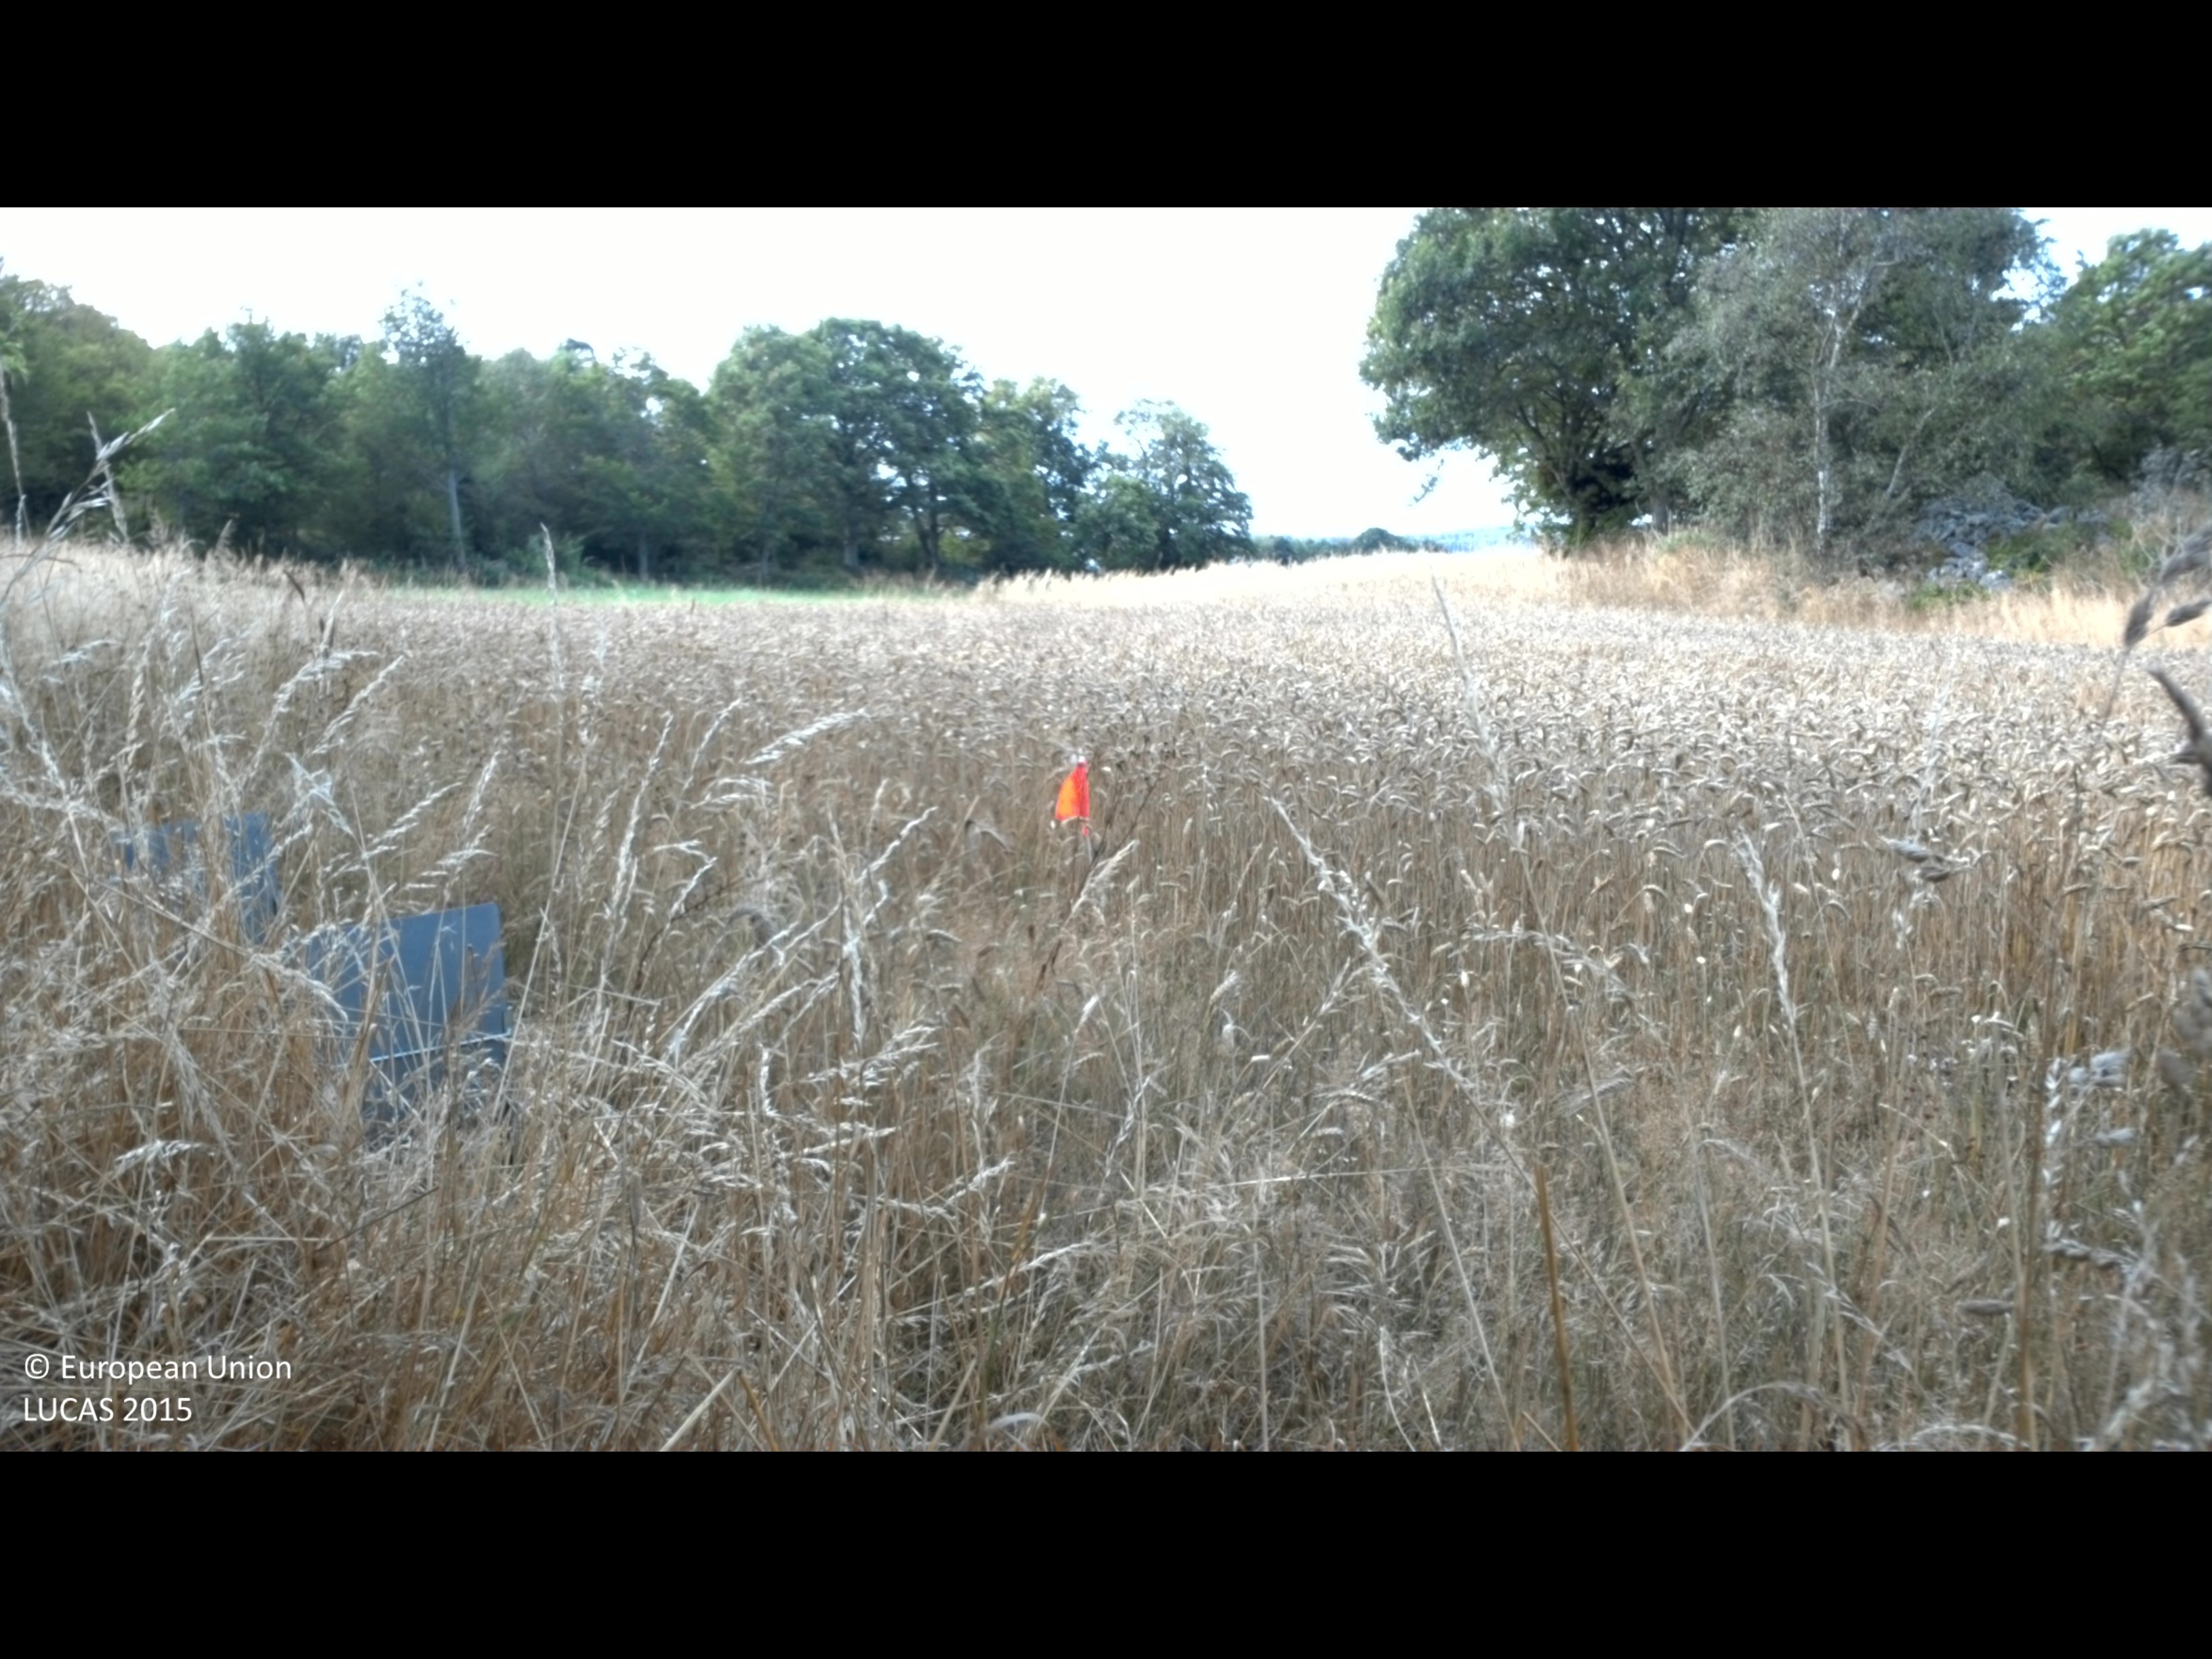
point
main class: Cropland
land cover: Common wheat
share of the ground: > 75 %
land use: Agriculture (excluding fallow land and kitchen gardens)
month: August
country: SE
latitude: 56.1478
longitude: 15.7790
